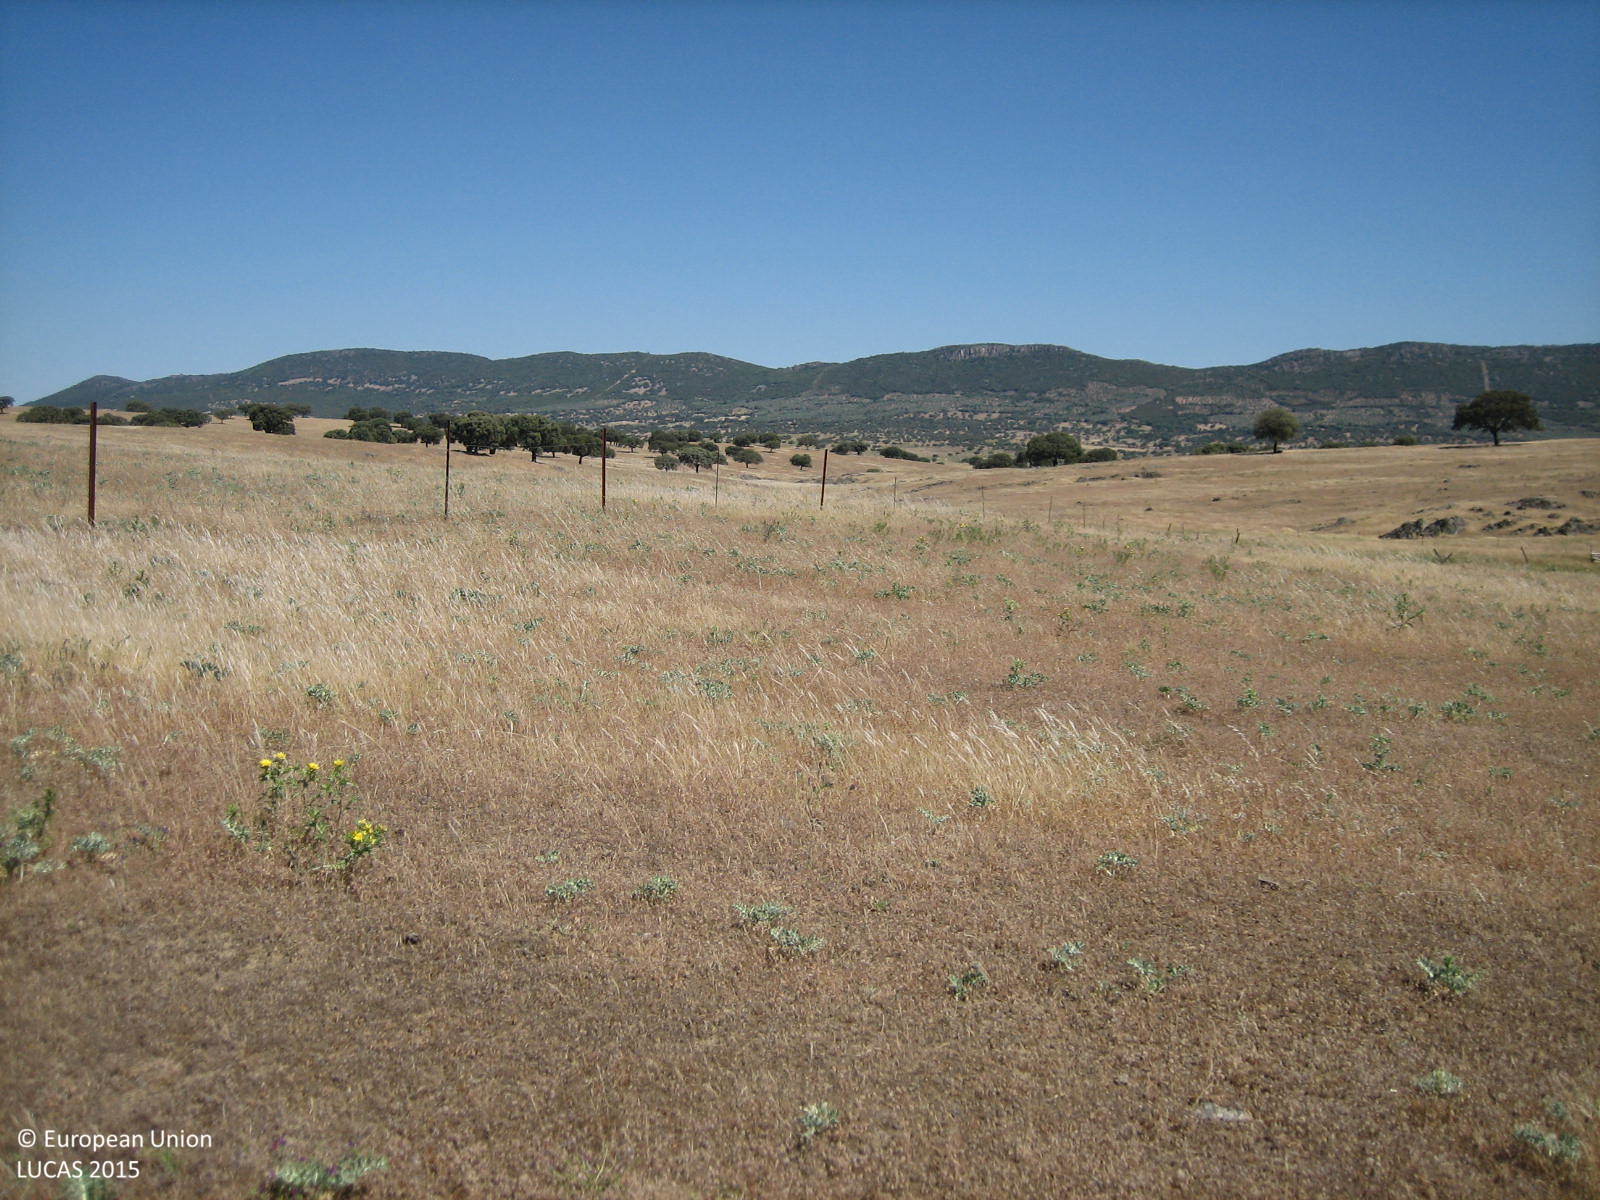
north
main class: Grassland
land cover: Spontaneously vegetated surfaces
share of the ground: > 75 %
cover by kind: herbaceous plants 100 %
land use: Agriculture (excluding fallow land and kitchen gardens)
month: May
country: ES
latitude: 38.9948
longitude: -4.8935
